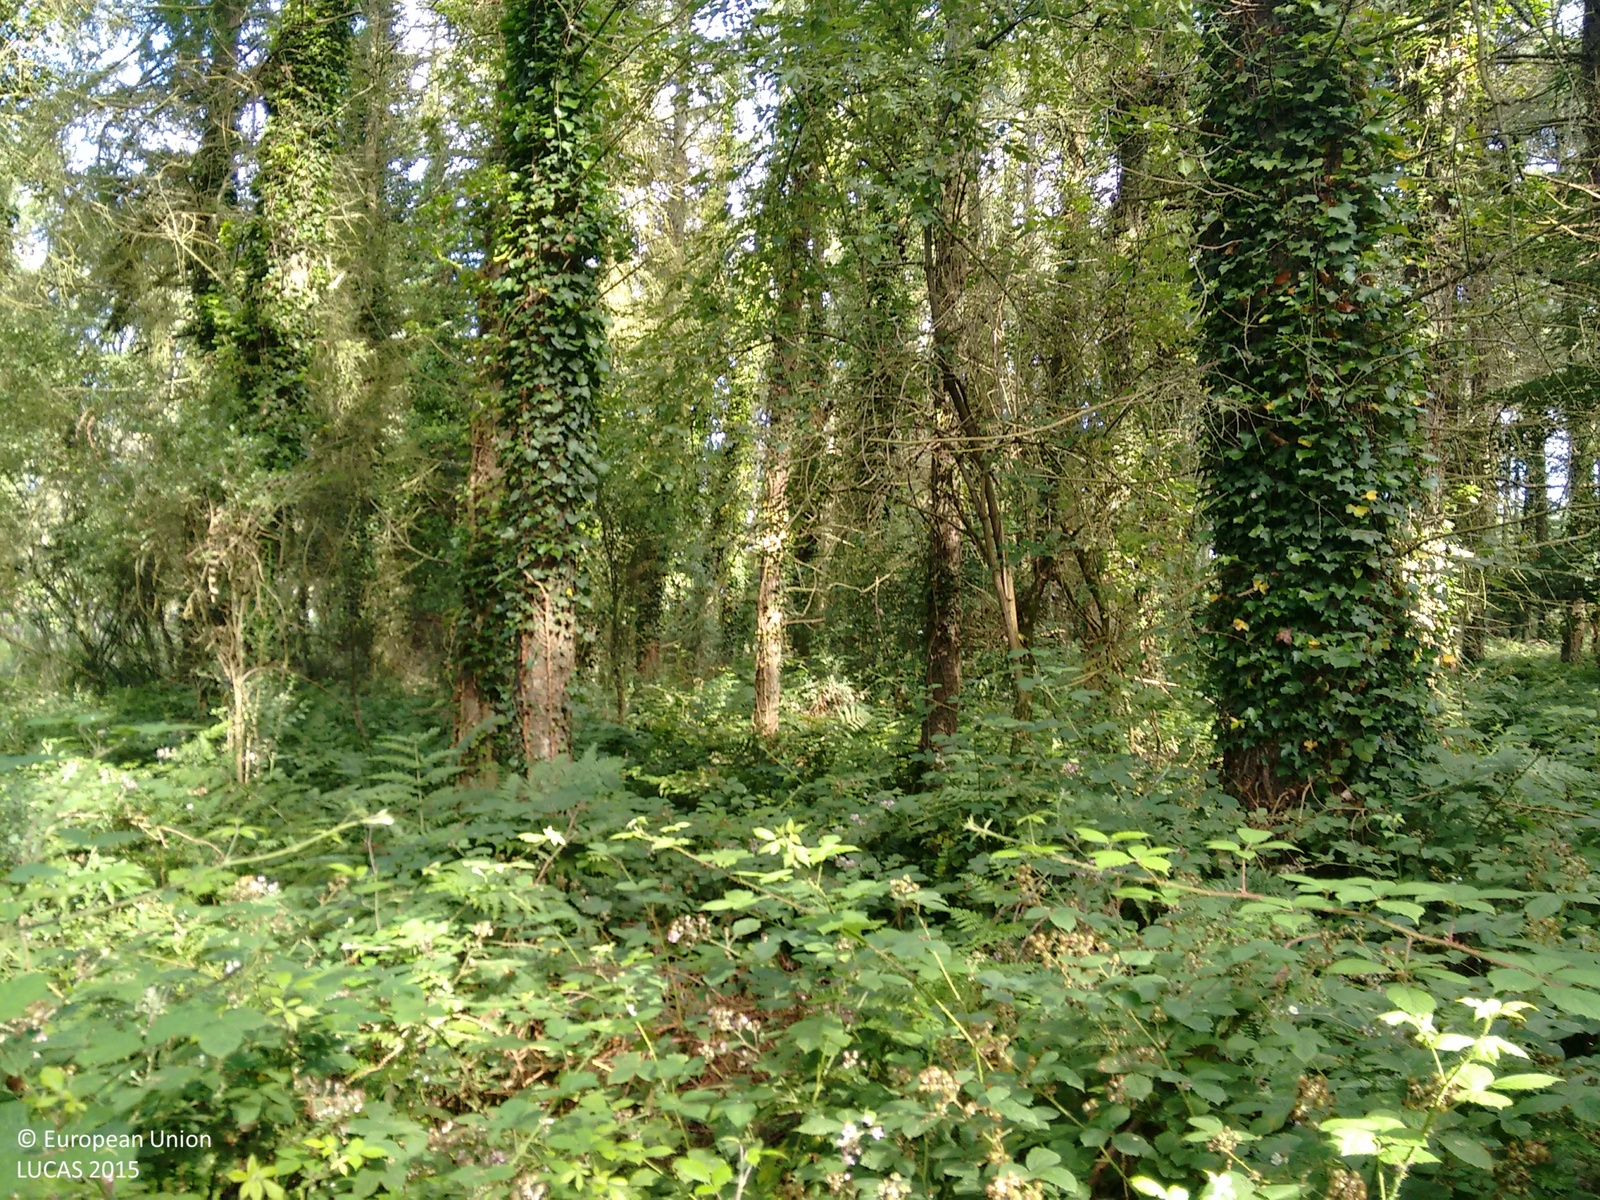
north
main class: Woodland
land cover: Pine dominated coniferous woodland
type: exotic forest
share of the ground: > 75 %
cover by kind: coniferous forest trees 100 %
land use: Forestry
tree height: > 5 m
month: August
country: GB
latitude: 53.2744
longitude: -4.3323
